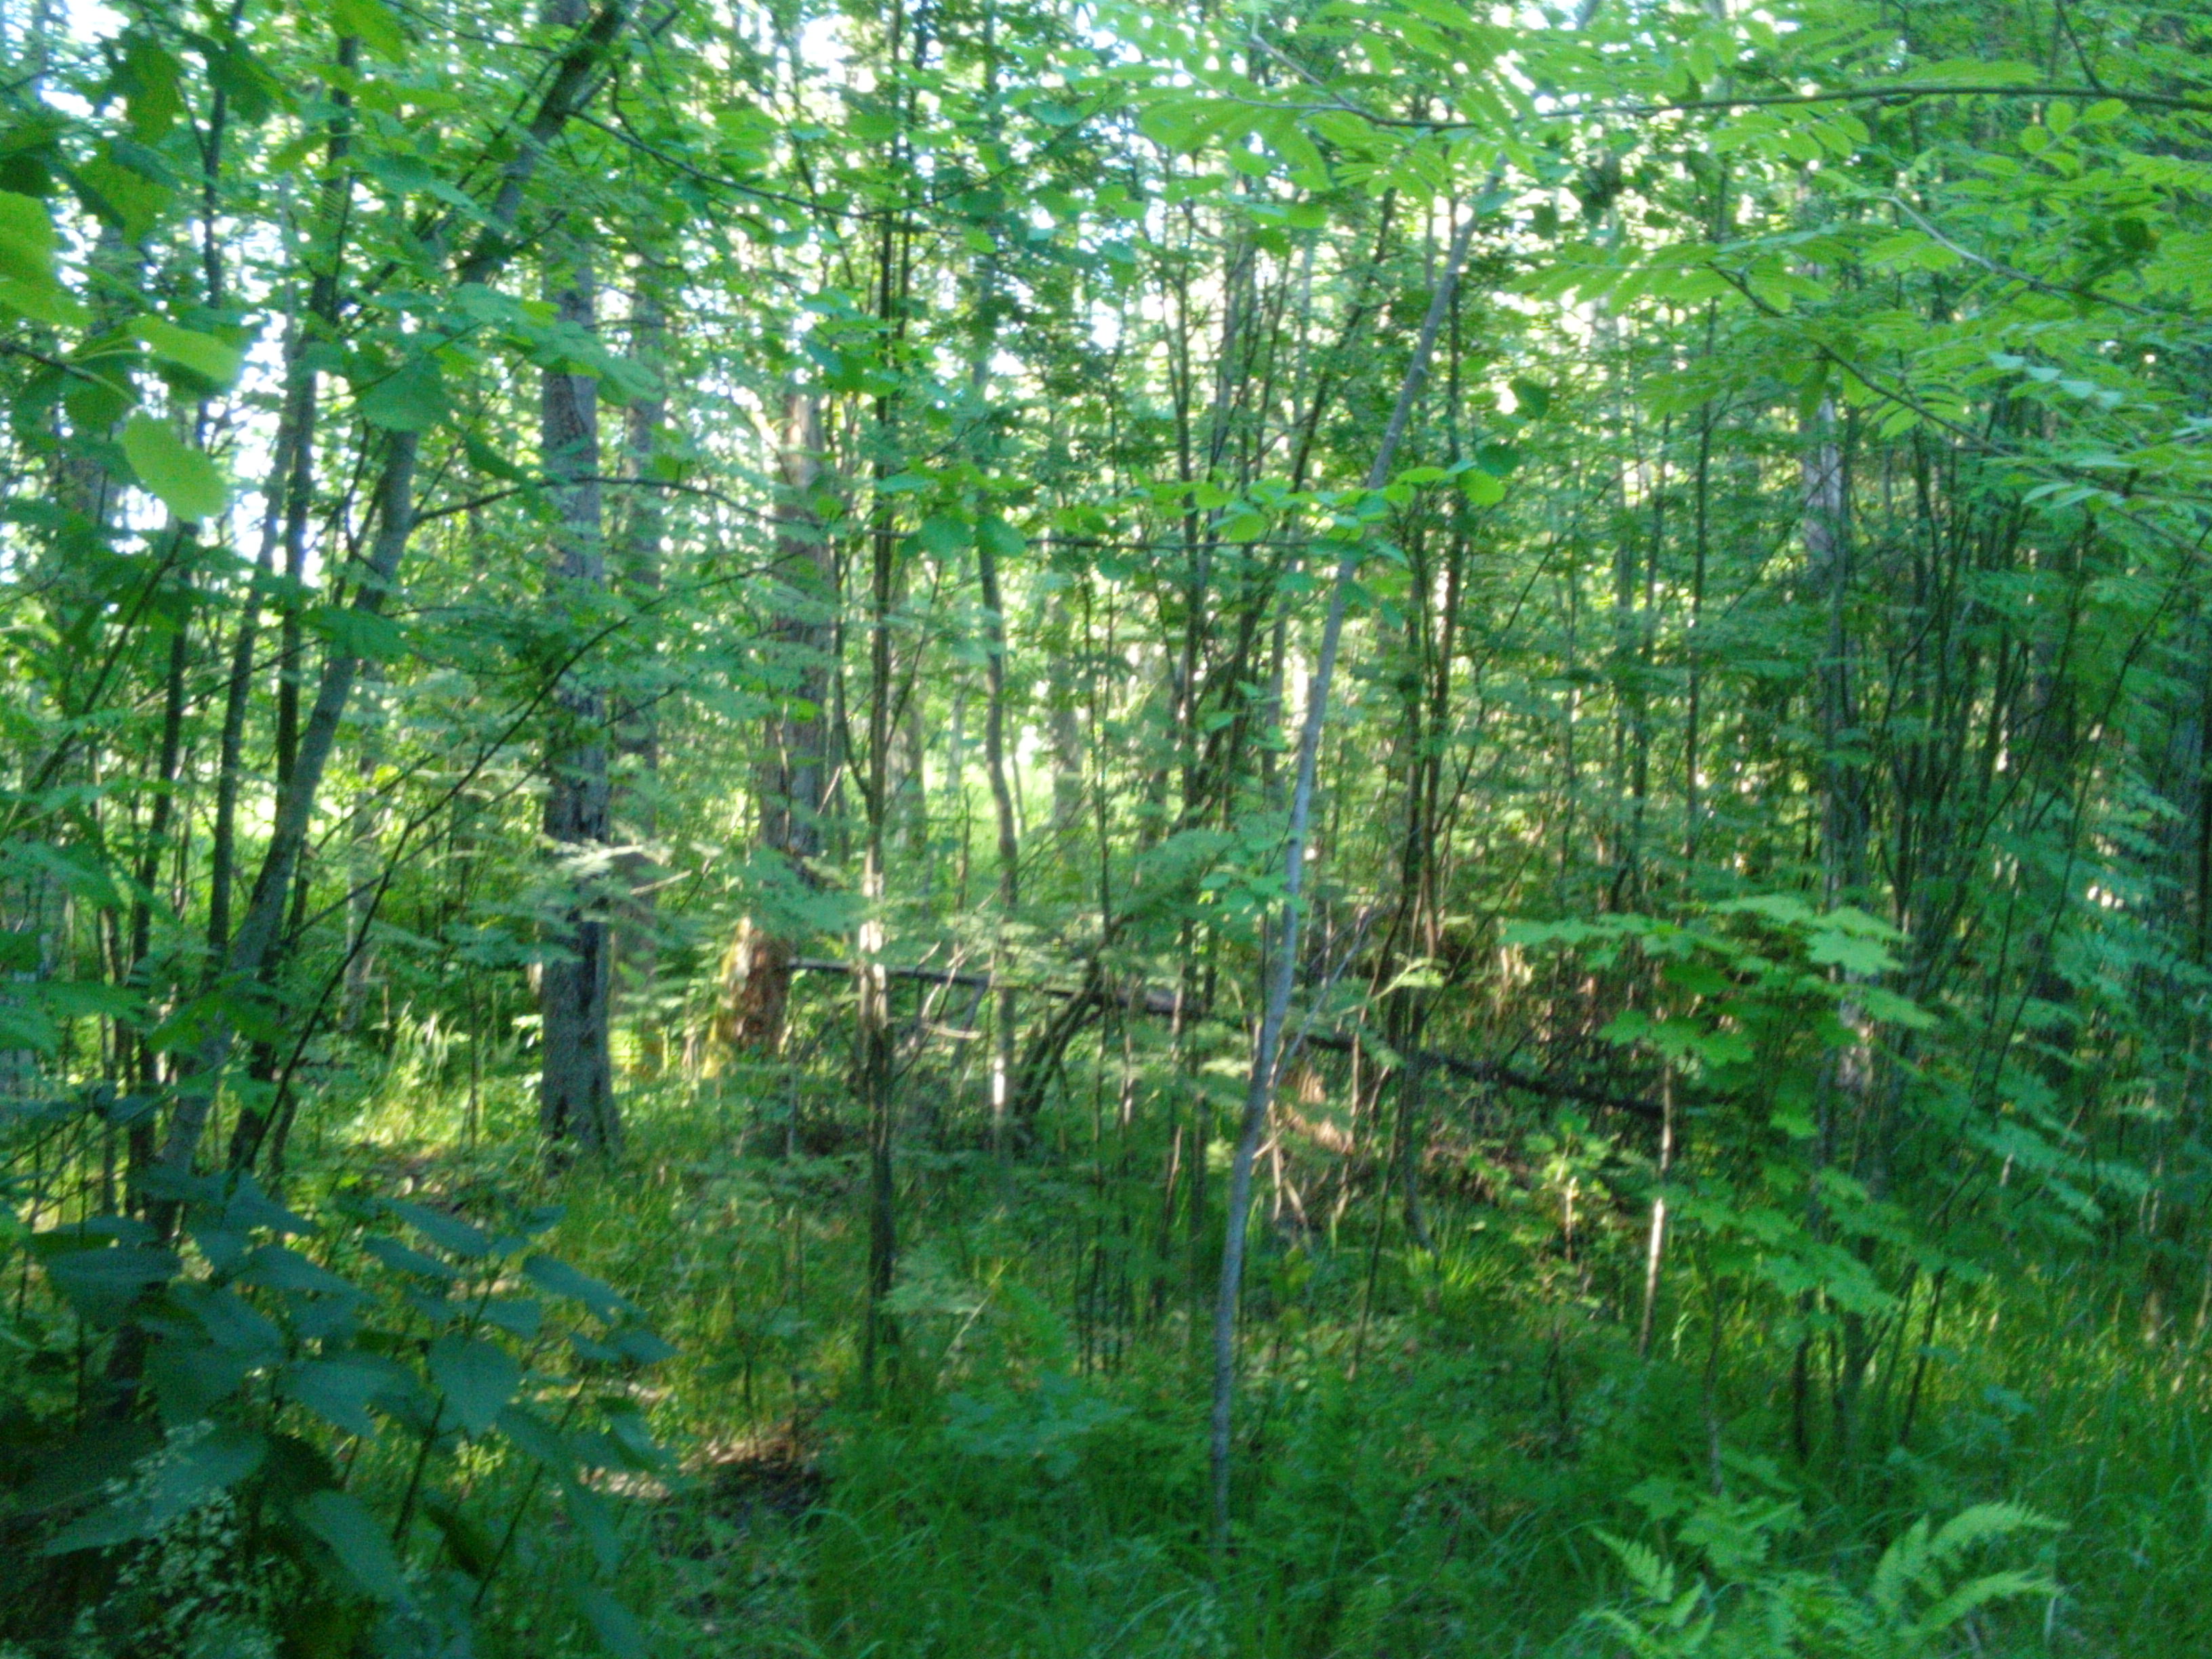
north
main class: Woodland
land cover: Spruce dominated mixed woodland
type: hemiboreal forest and nemoral coniferous forest and mixed broadleaved-coniferous forest
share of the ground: > 75 %
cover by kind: broadleaved forest trees 60 %, coniferous forest trees 30 %, shrubs 10 %
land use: Forestry
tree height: > 5 m
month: June
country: LV
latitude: 56.8031
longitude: 22.2190
